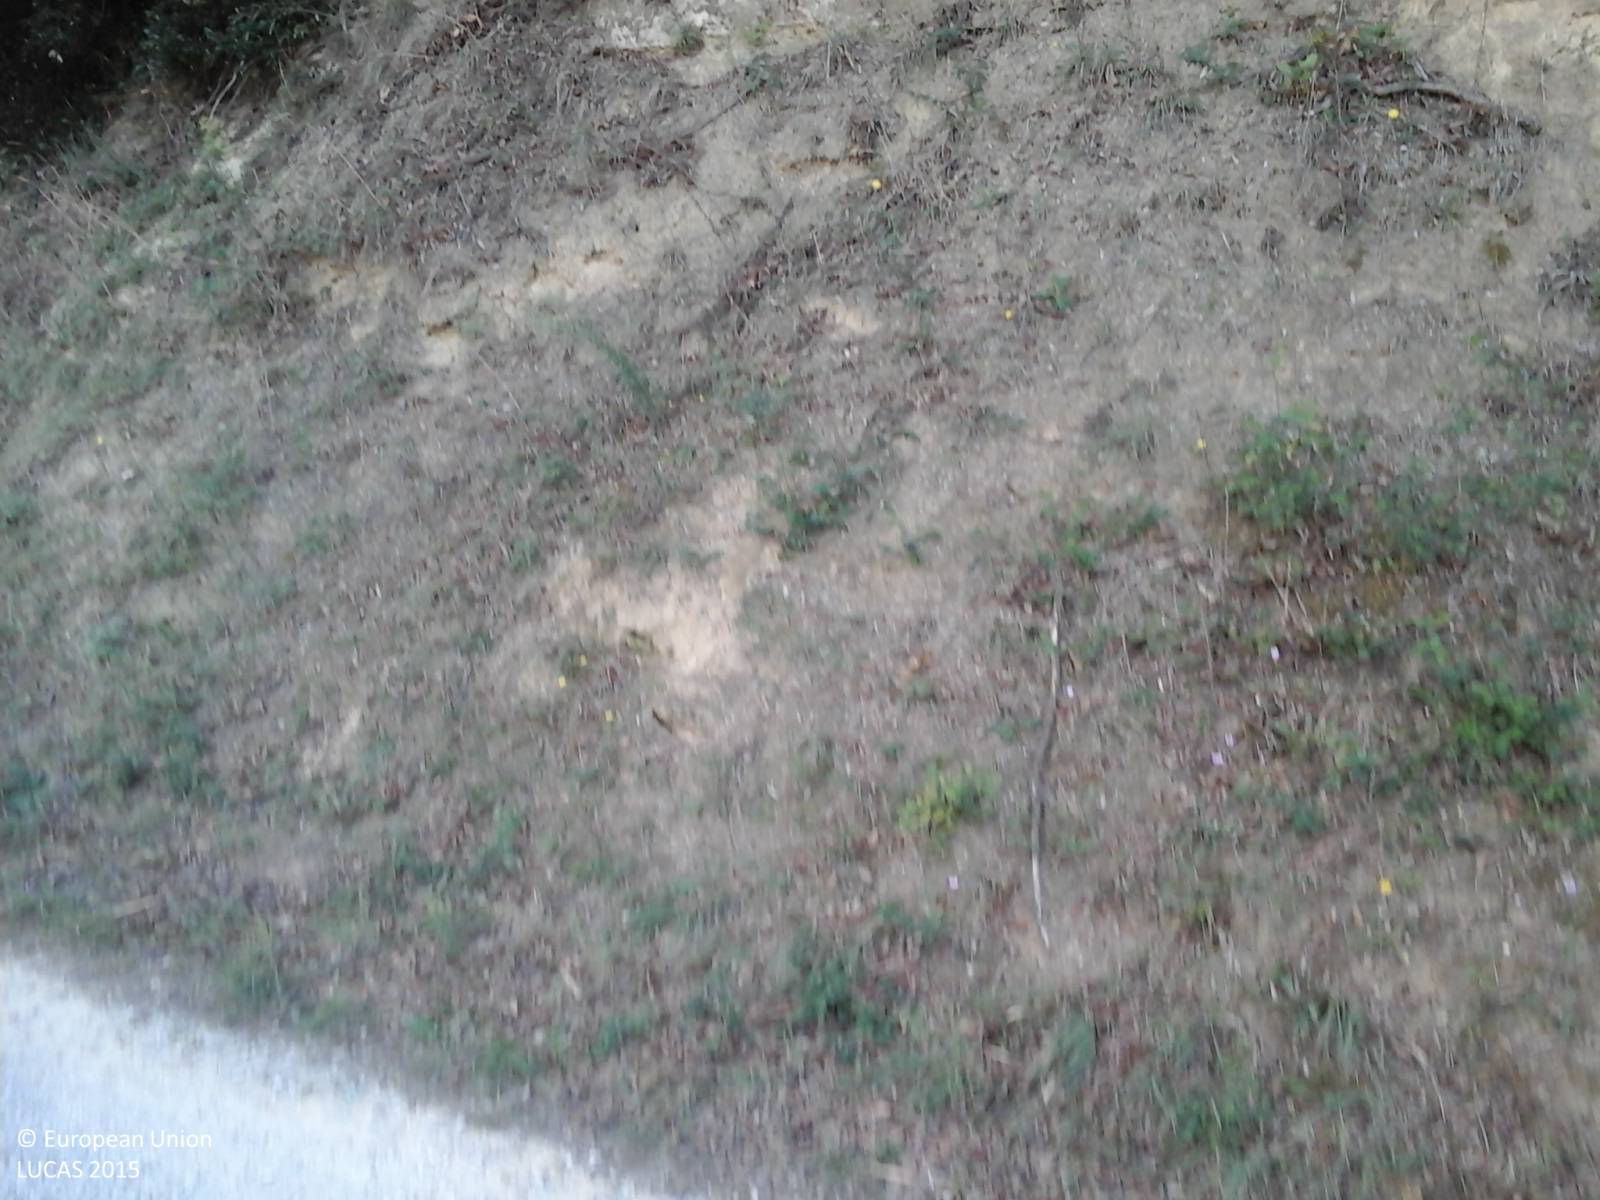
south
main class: Cropland
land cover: Olive groves
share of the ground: 50 - 75 %
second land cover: Spontaneously vegetated surfaces
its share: > 75 %
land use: Kitchen garden
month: September
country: IT
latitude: 42.2599
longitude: 12.5732
